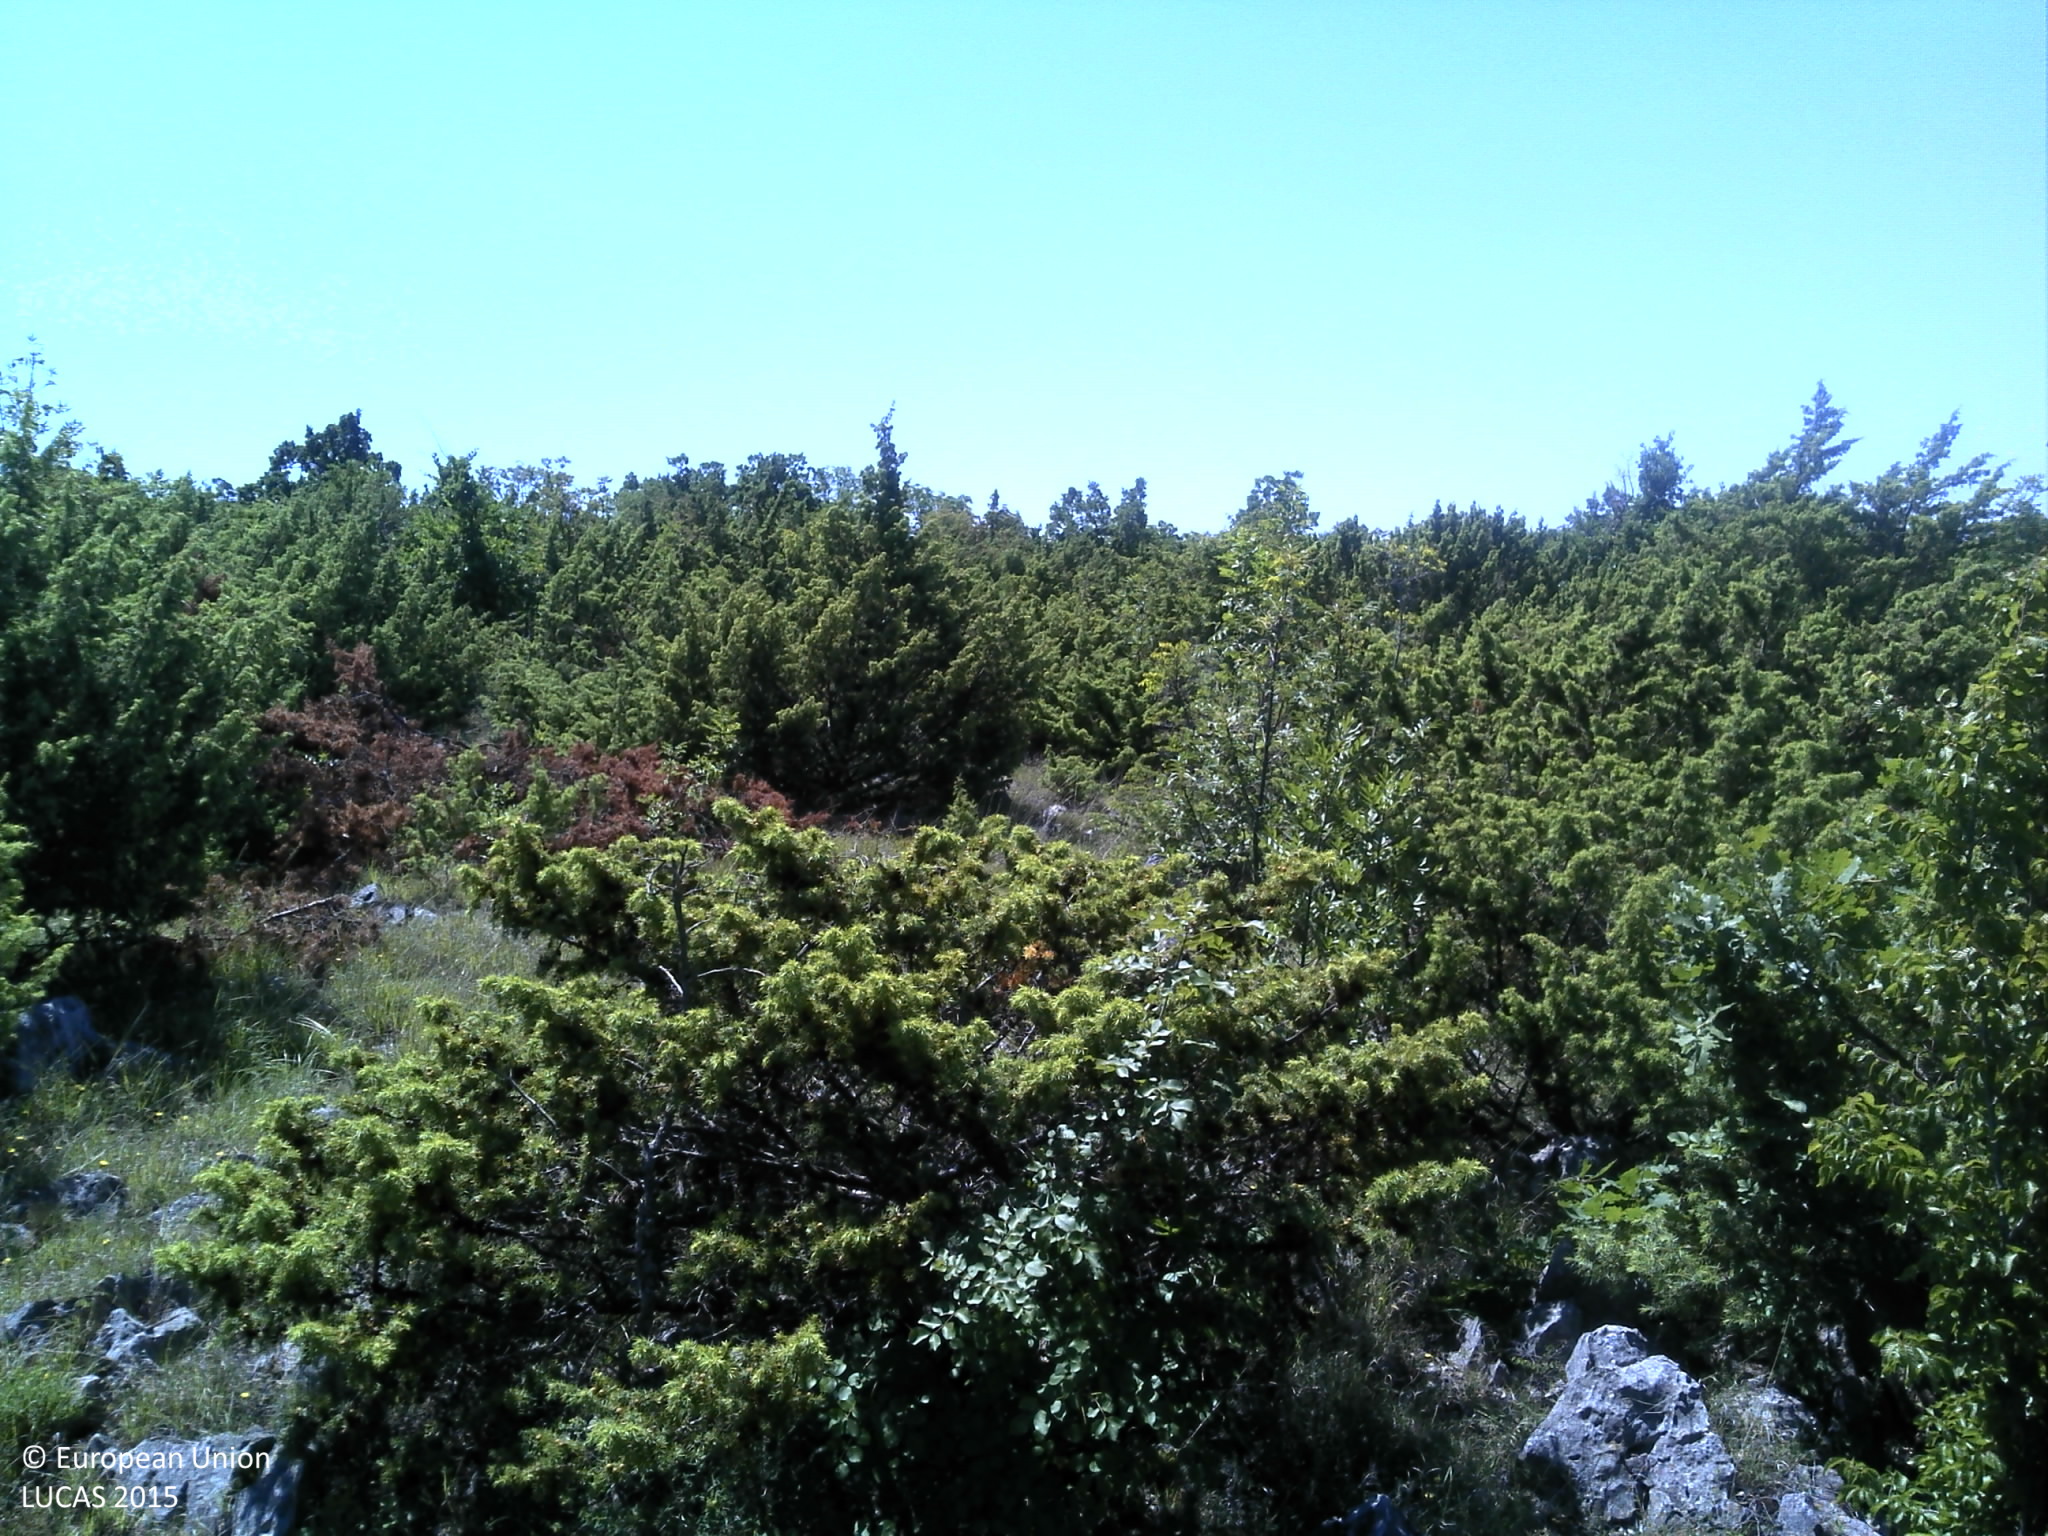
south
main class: Shrubland
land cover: Shrubland with sparse tree cover
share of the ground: 50 - 75 %
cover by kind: shrubs 50 %, herbaceous plants 35 %, unconsolidated bare surface 10 %, coniferous forest trees 5 %
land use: Semi-natural and natural areas not in use
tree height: < 5 m
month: May
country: HR
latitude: 43.9355
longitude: 16.1086
